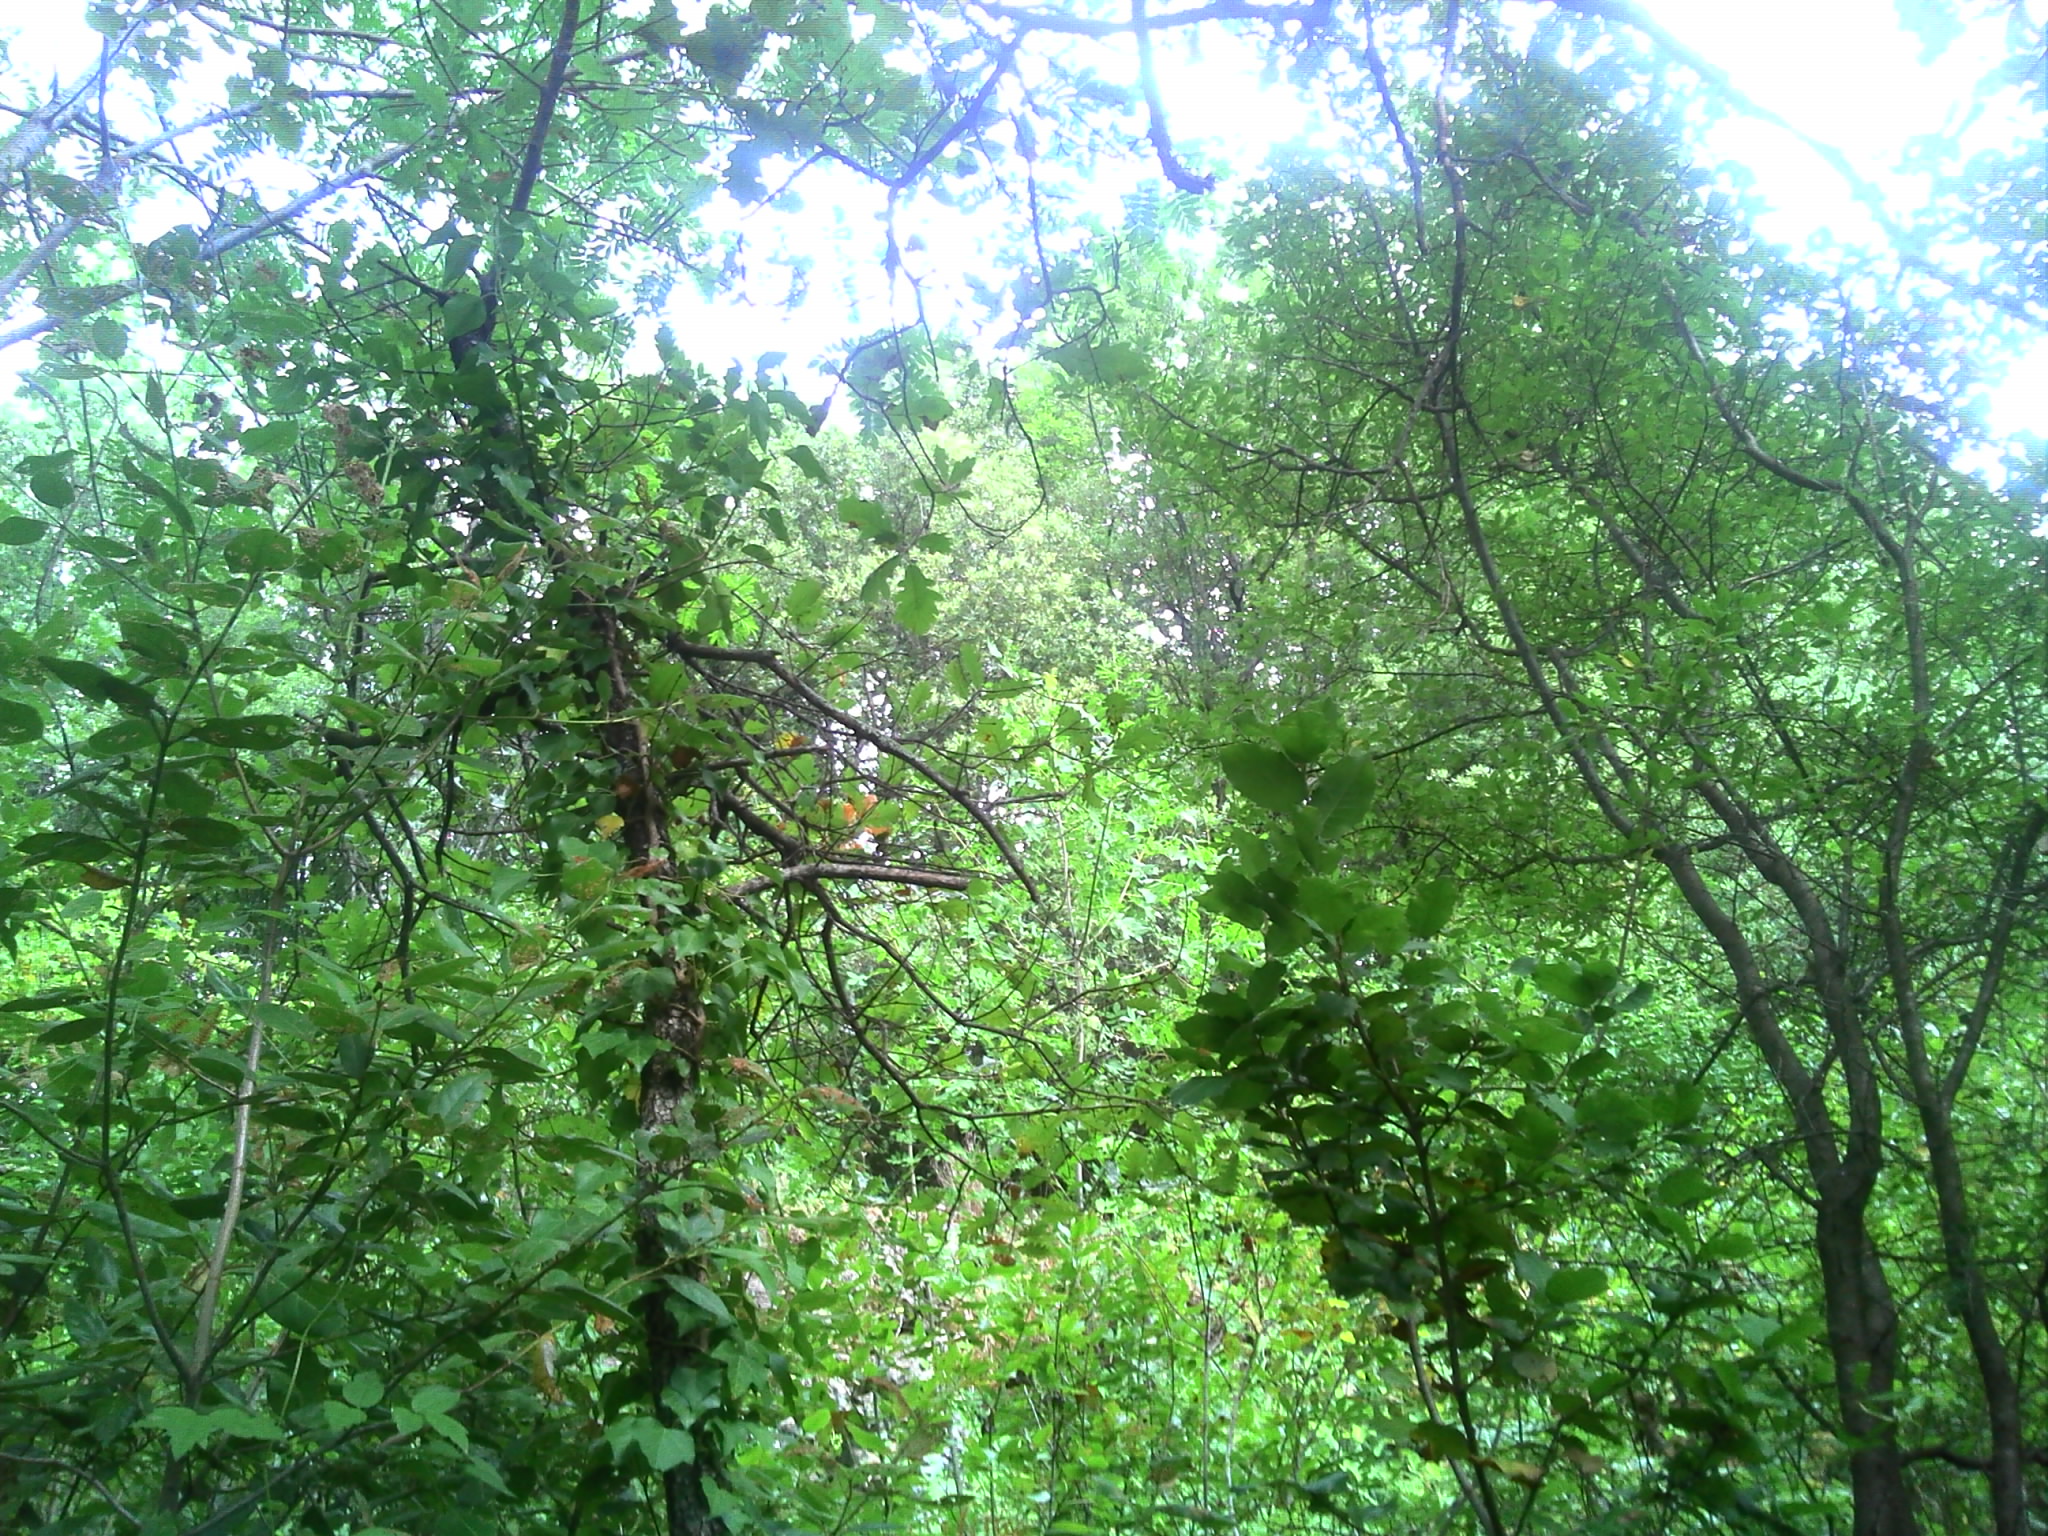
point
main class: Woodland
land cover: Broadleaved woodland
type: mesophytic deciduous forest
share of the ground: > 75 %
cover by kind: broadleaved forest trees 80 %, herbaceous plants 10 %, consolidated bare surface 10 %
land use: Forestry
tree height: > 5 m
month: July
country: FR
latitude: 44.1016
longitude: 3.9487
